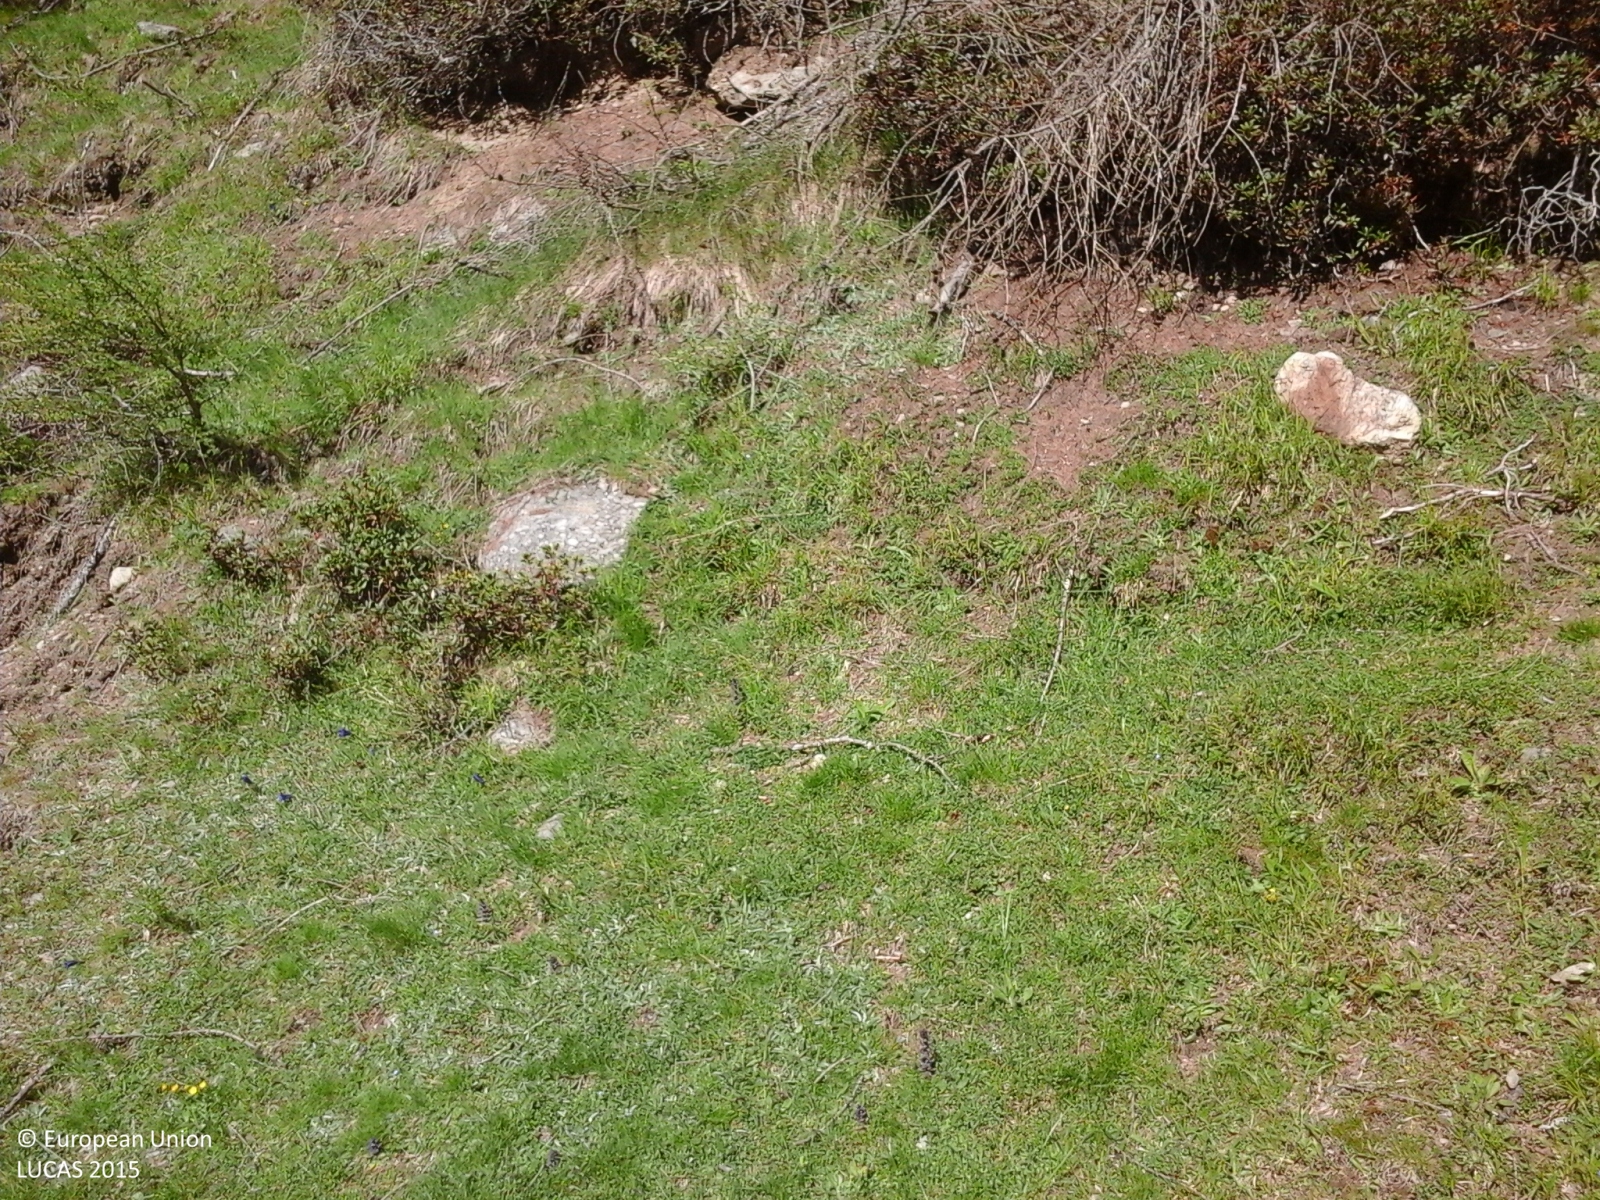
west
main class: Woodland
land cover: Other coniferous woodland
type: alpine coniferous forest
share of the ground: > 75 %
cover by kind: coniferous forest trees 100 %
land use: Forestry
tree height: > 5 m
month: May
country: IT
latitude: 46.6726
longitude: 10.7703
